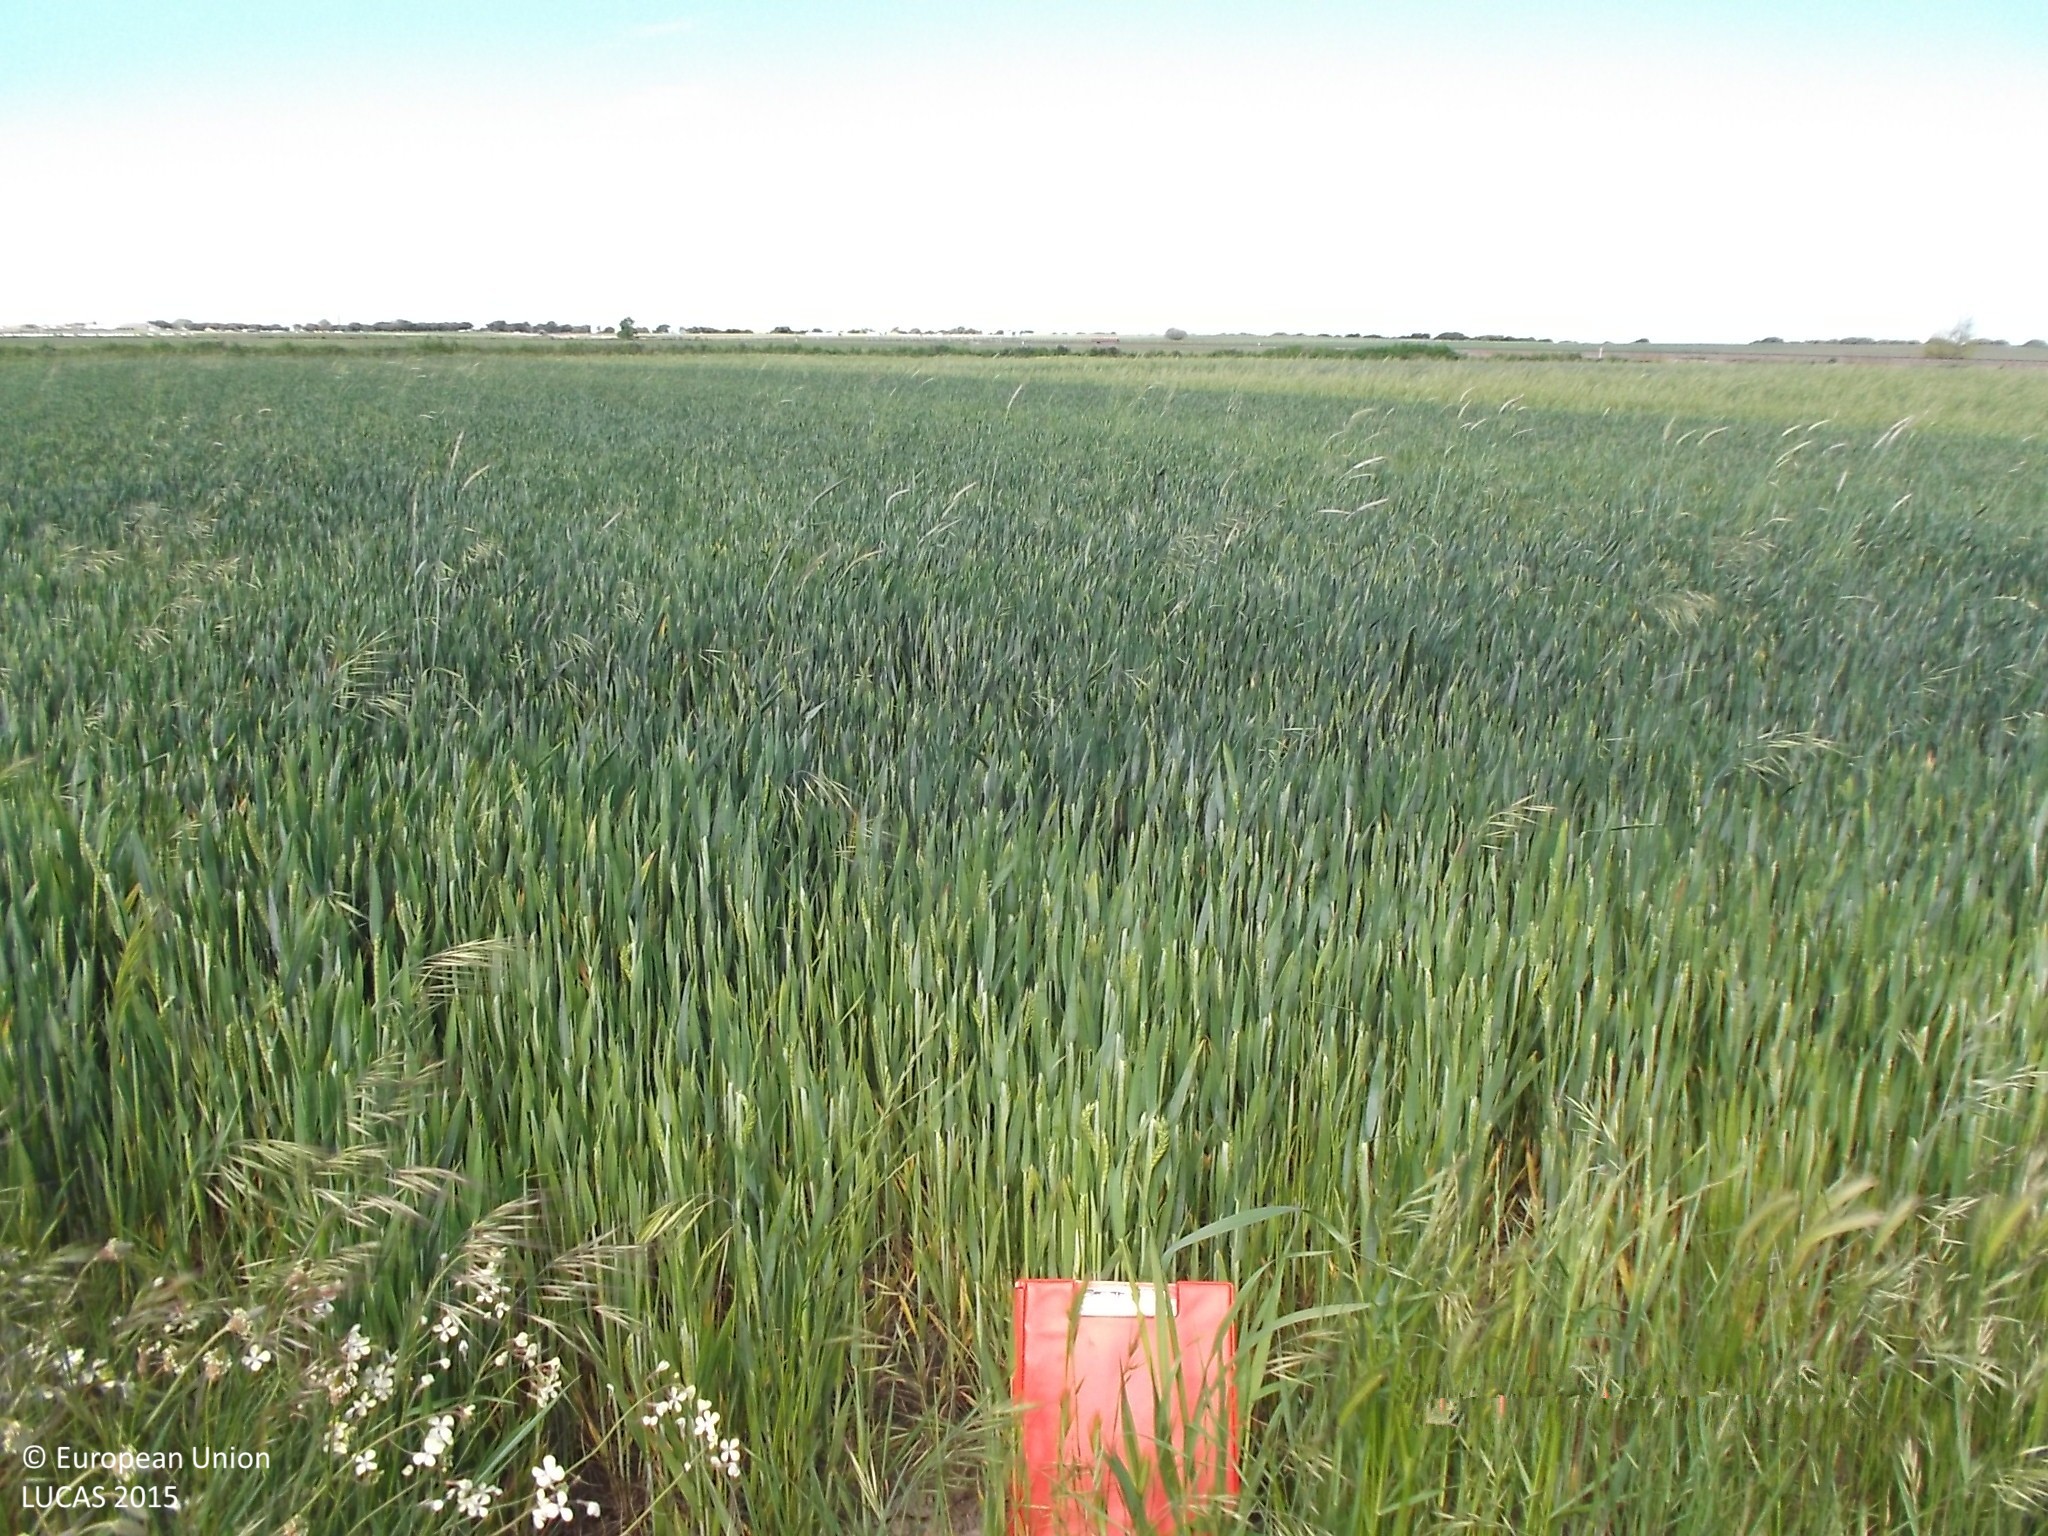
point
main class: Cropland
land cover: Common wheat
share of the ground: > 75 %
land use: Agriculture (excluding fallow land and kitchen gardens)
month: May
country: ES
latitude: 40.8034
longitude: -6.2185
